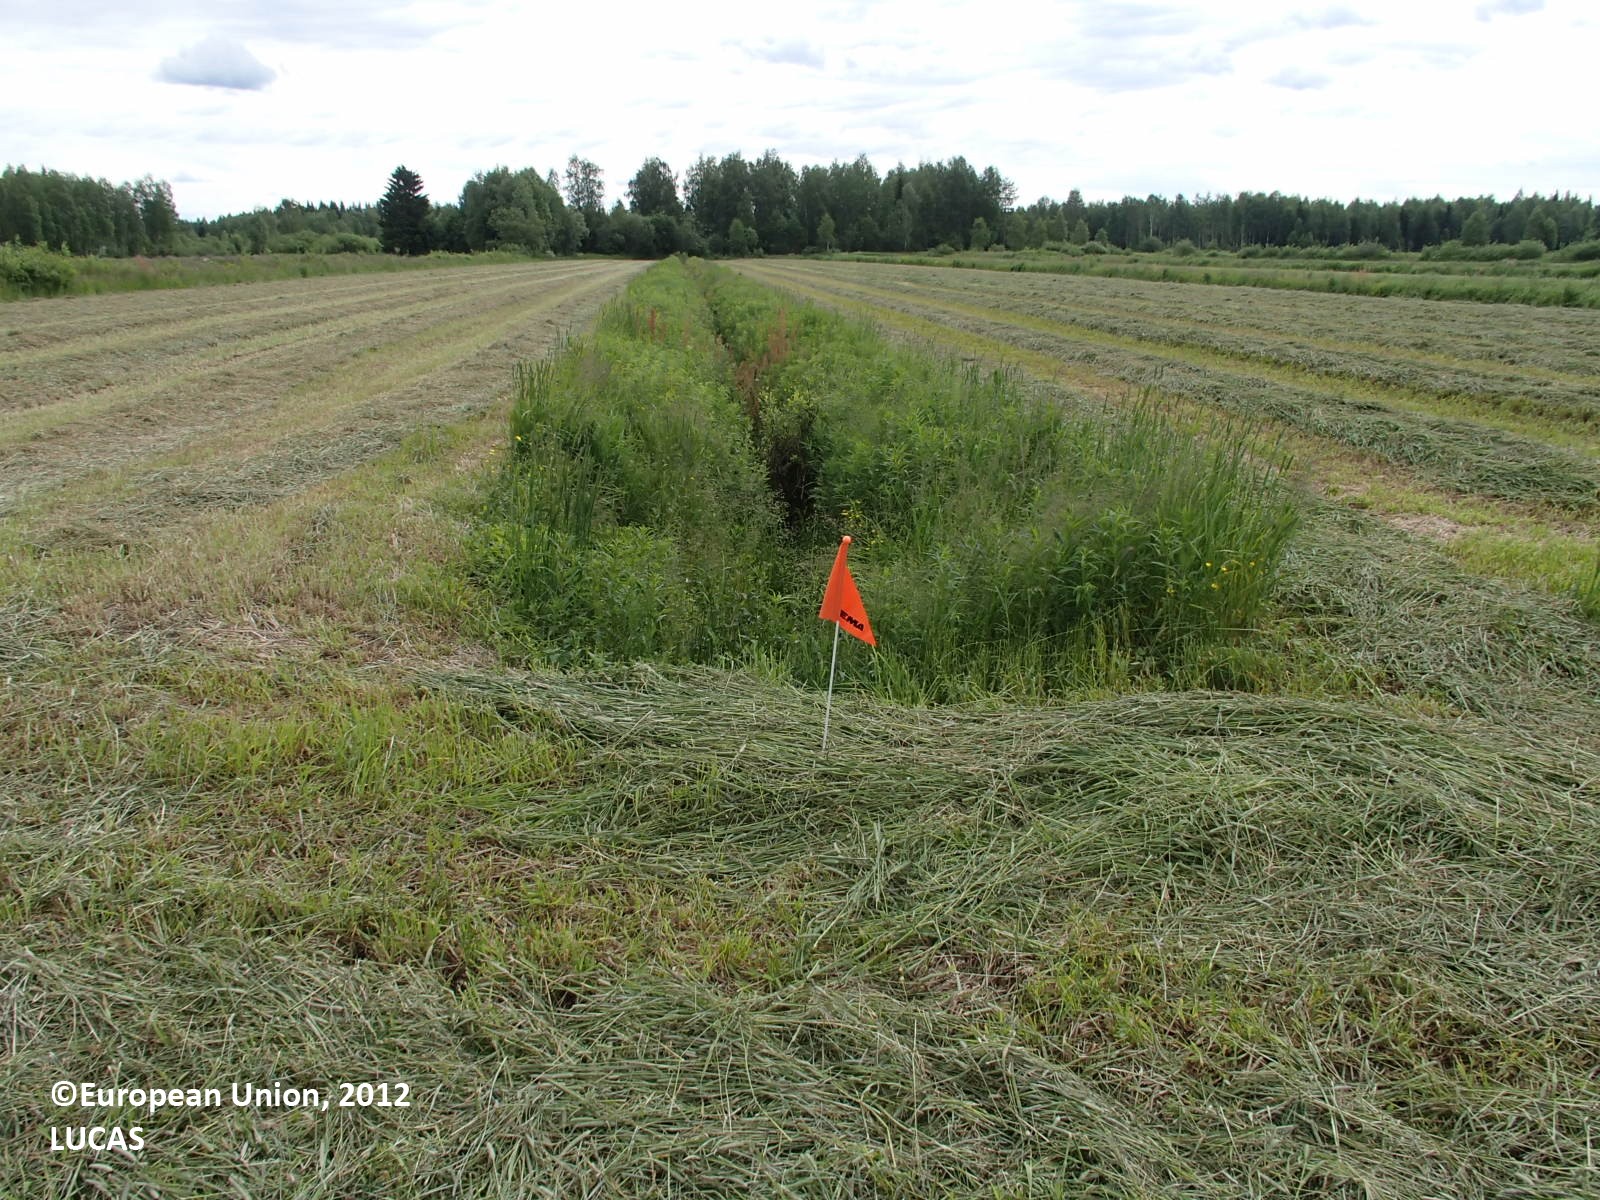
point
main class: Cropland
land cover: Temporary grasslands
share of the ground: > 75 %
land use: Agriculture (excluding fallow land and kitchen gardens)
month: July
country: FI
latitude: 64.1385
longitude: 27.0025
